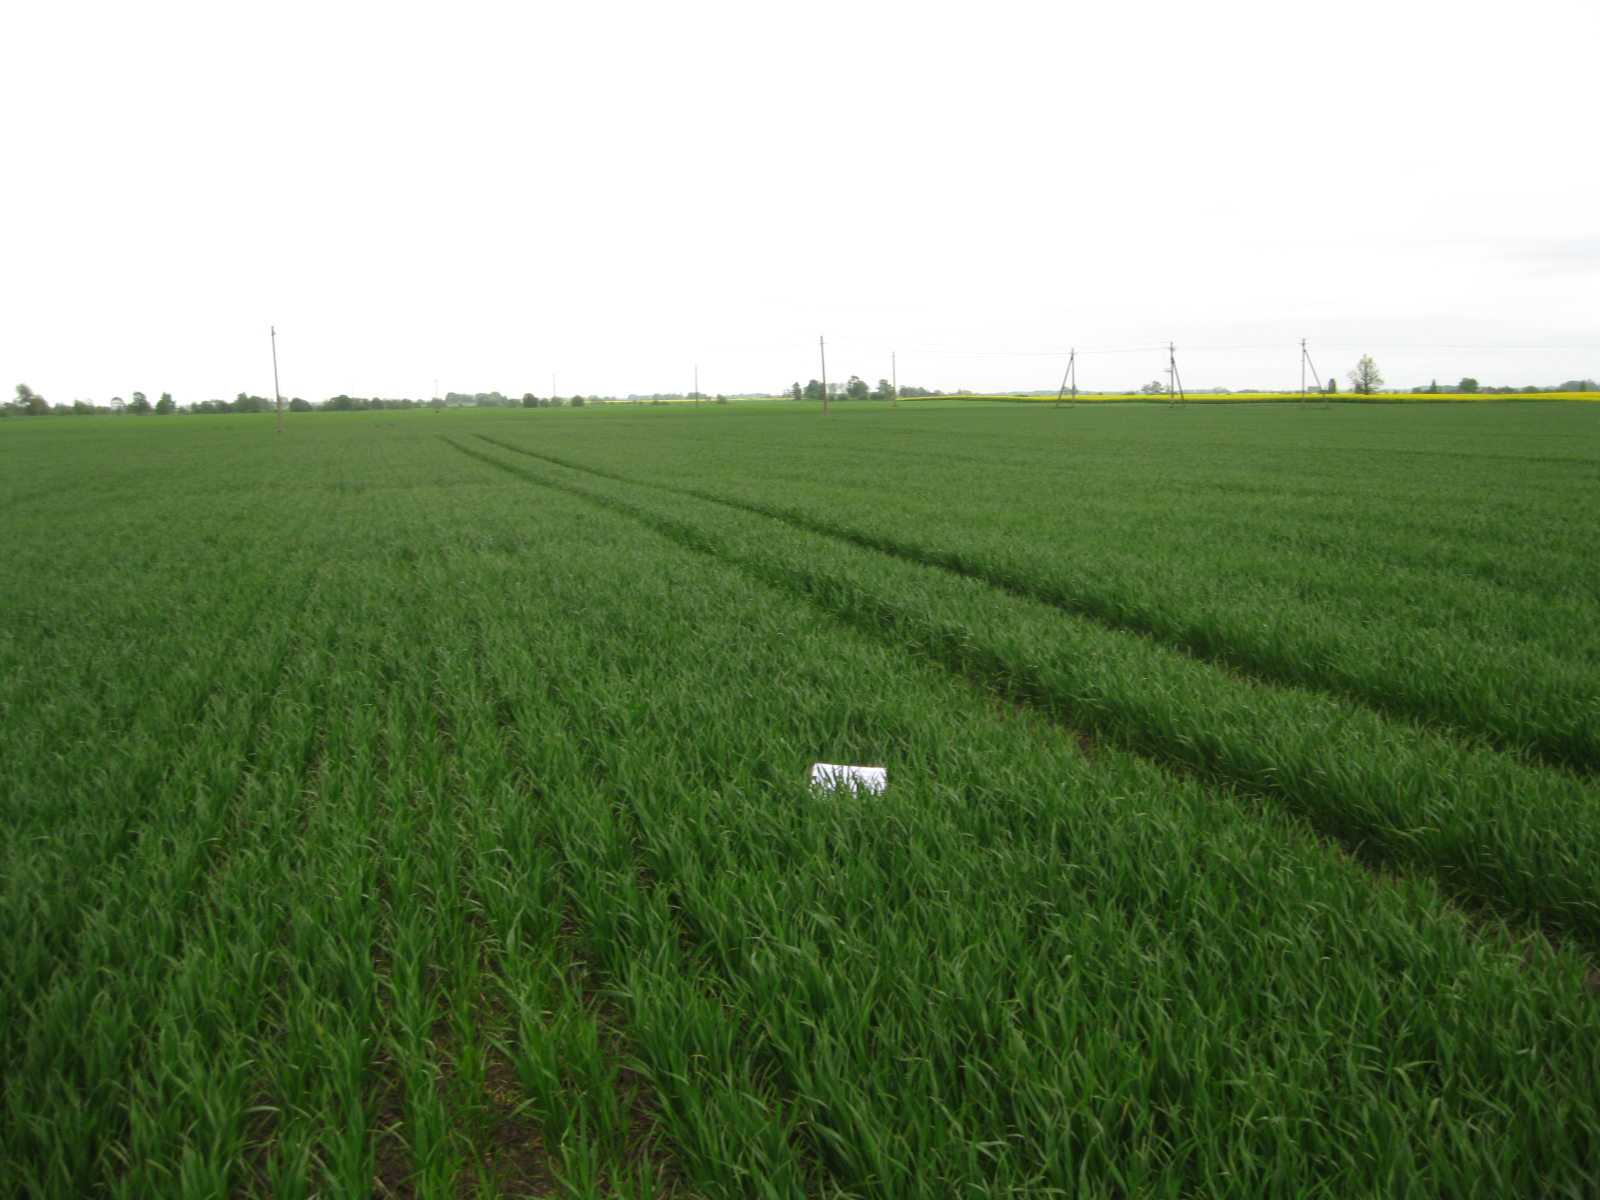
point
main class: Cropland
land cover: Common wheat
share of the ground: > 75 %
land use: Agriculture (excluding fallow land and kitchen gardens)
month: May
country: LT
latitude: 56.2453
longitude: 23.4201
